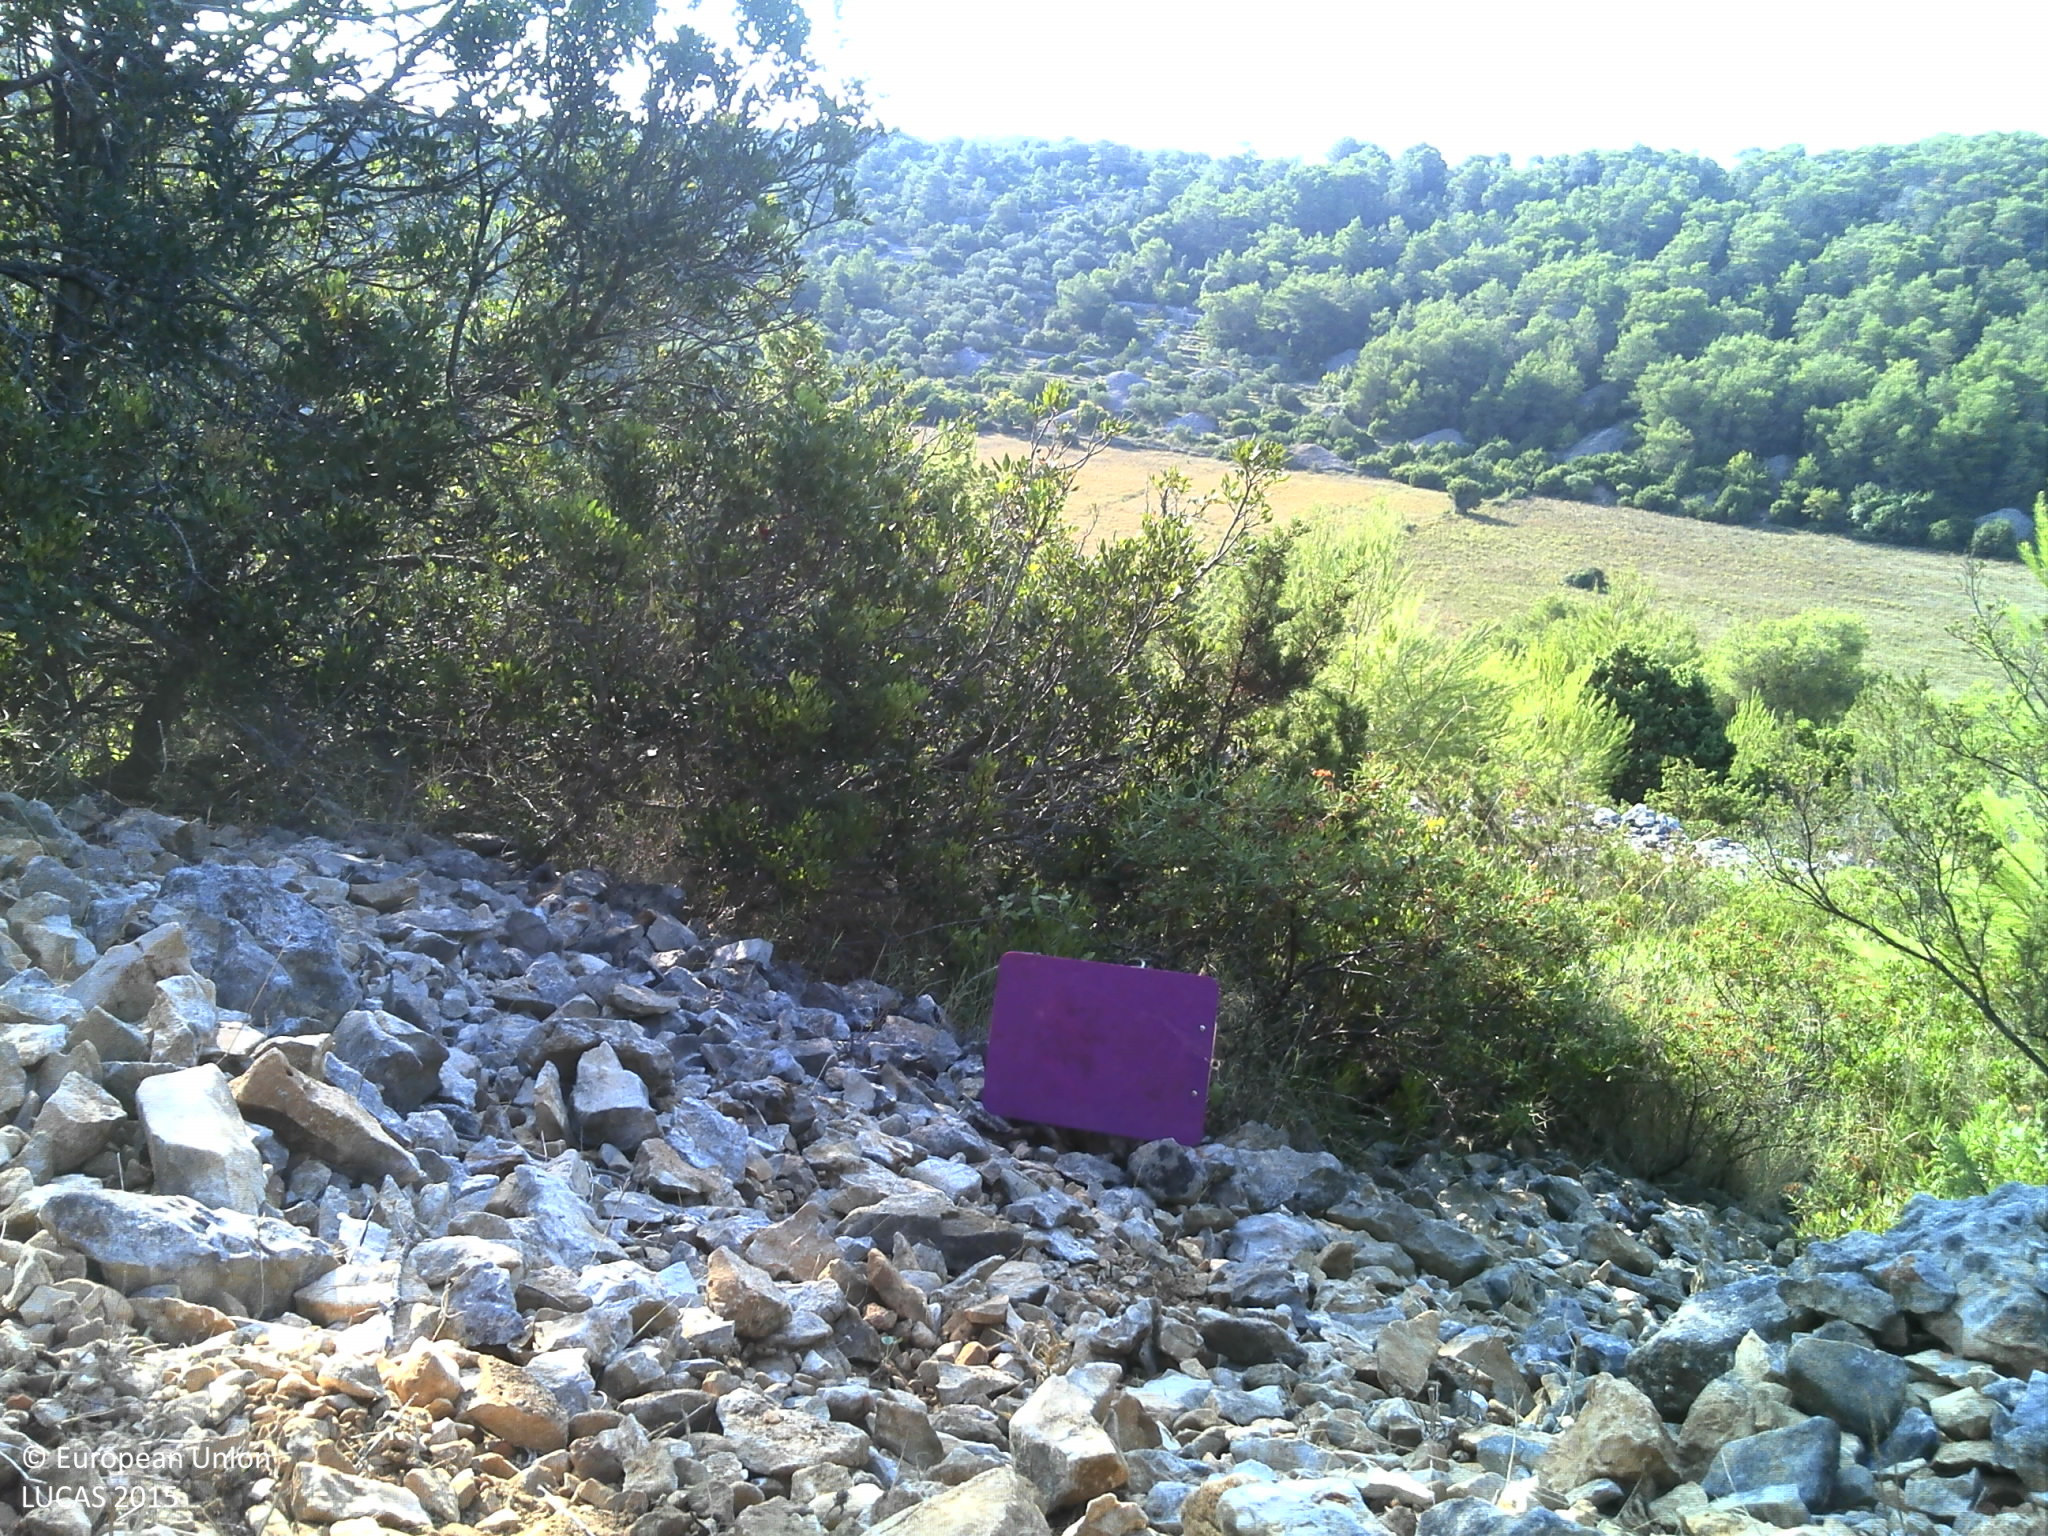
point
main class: Shrubland
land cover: Shrubland with sparse tree cover
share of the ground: > 75 %
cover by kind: shrubs 60 %, unconsolidated bare surface 20 %, herbaceous plants 10 %, coniferous forest trees 5 %, consolidated bare surface 5 %
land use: Abandoned areas
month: August
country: HR
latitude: 43.0456
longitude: 16.1633
